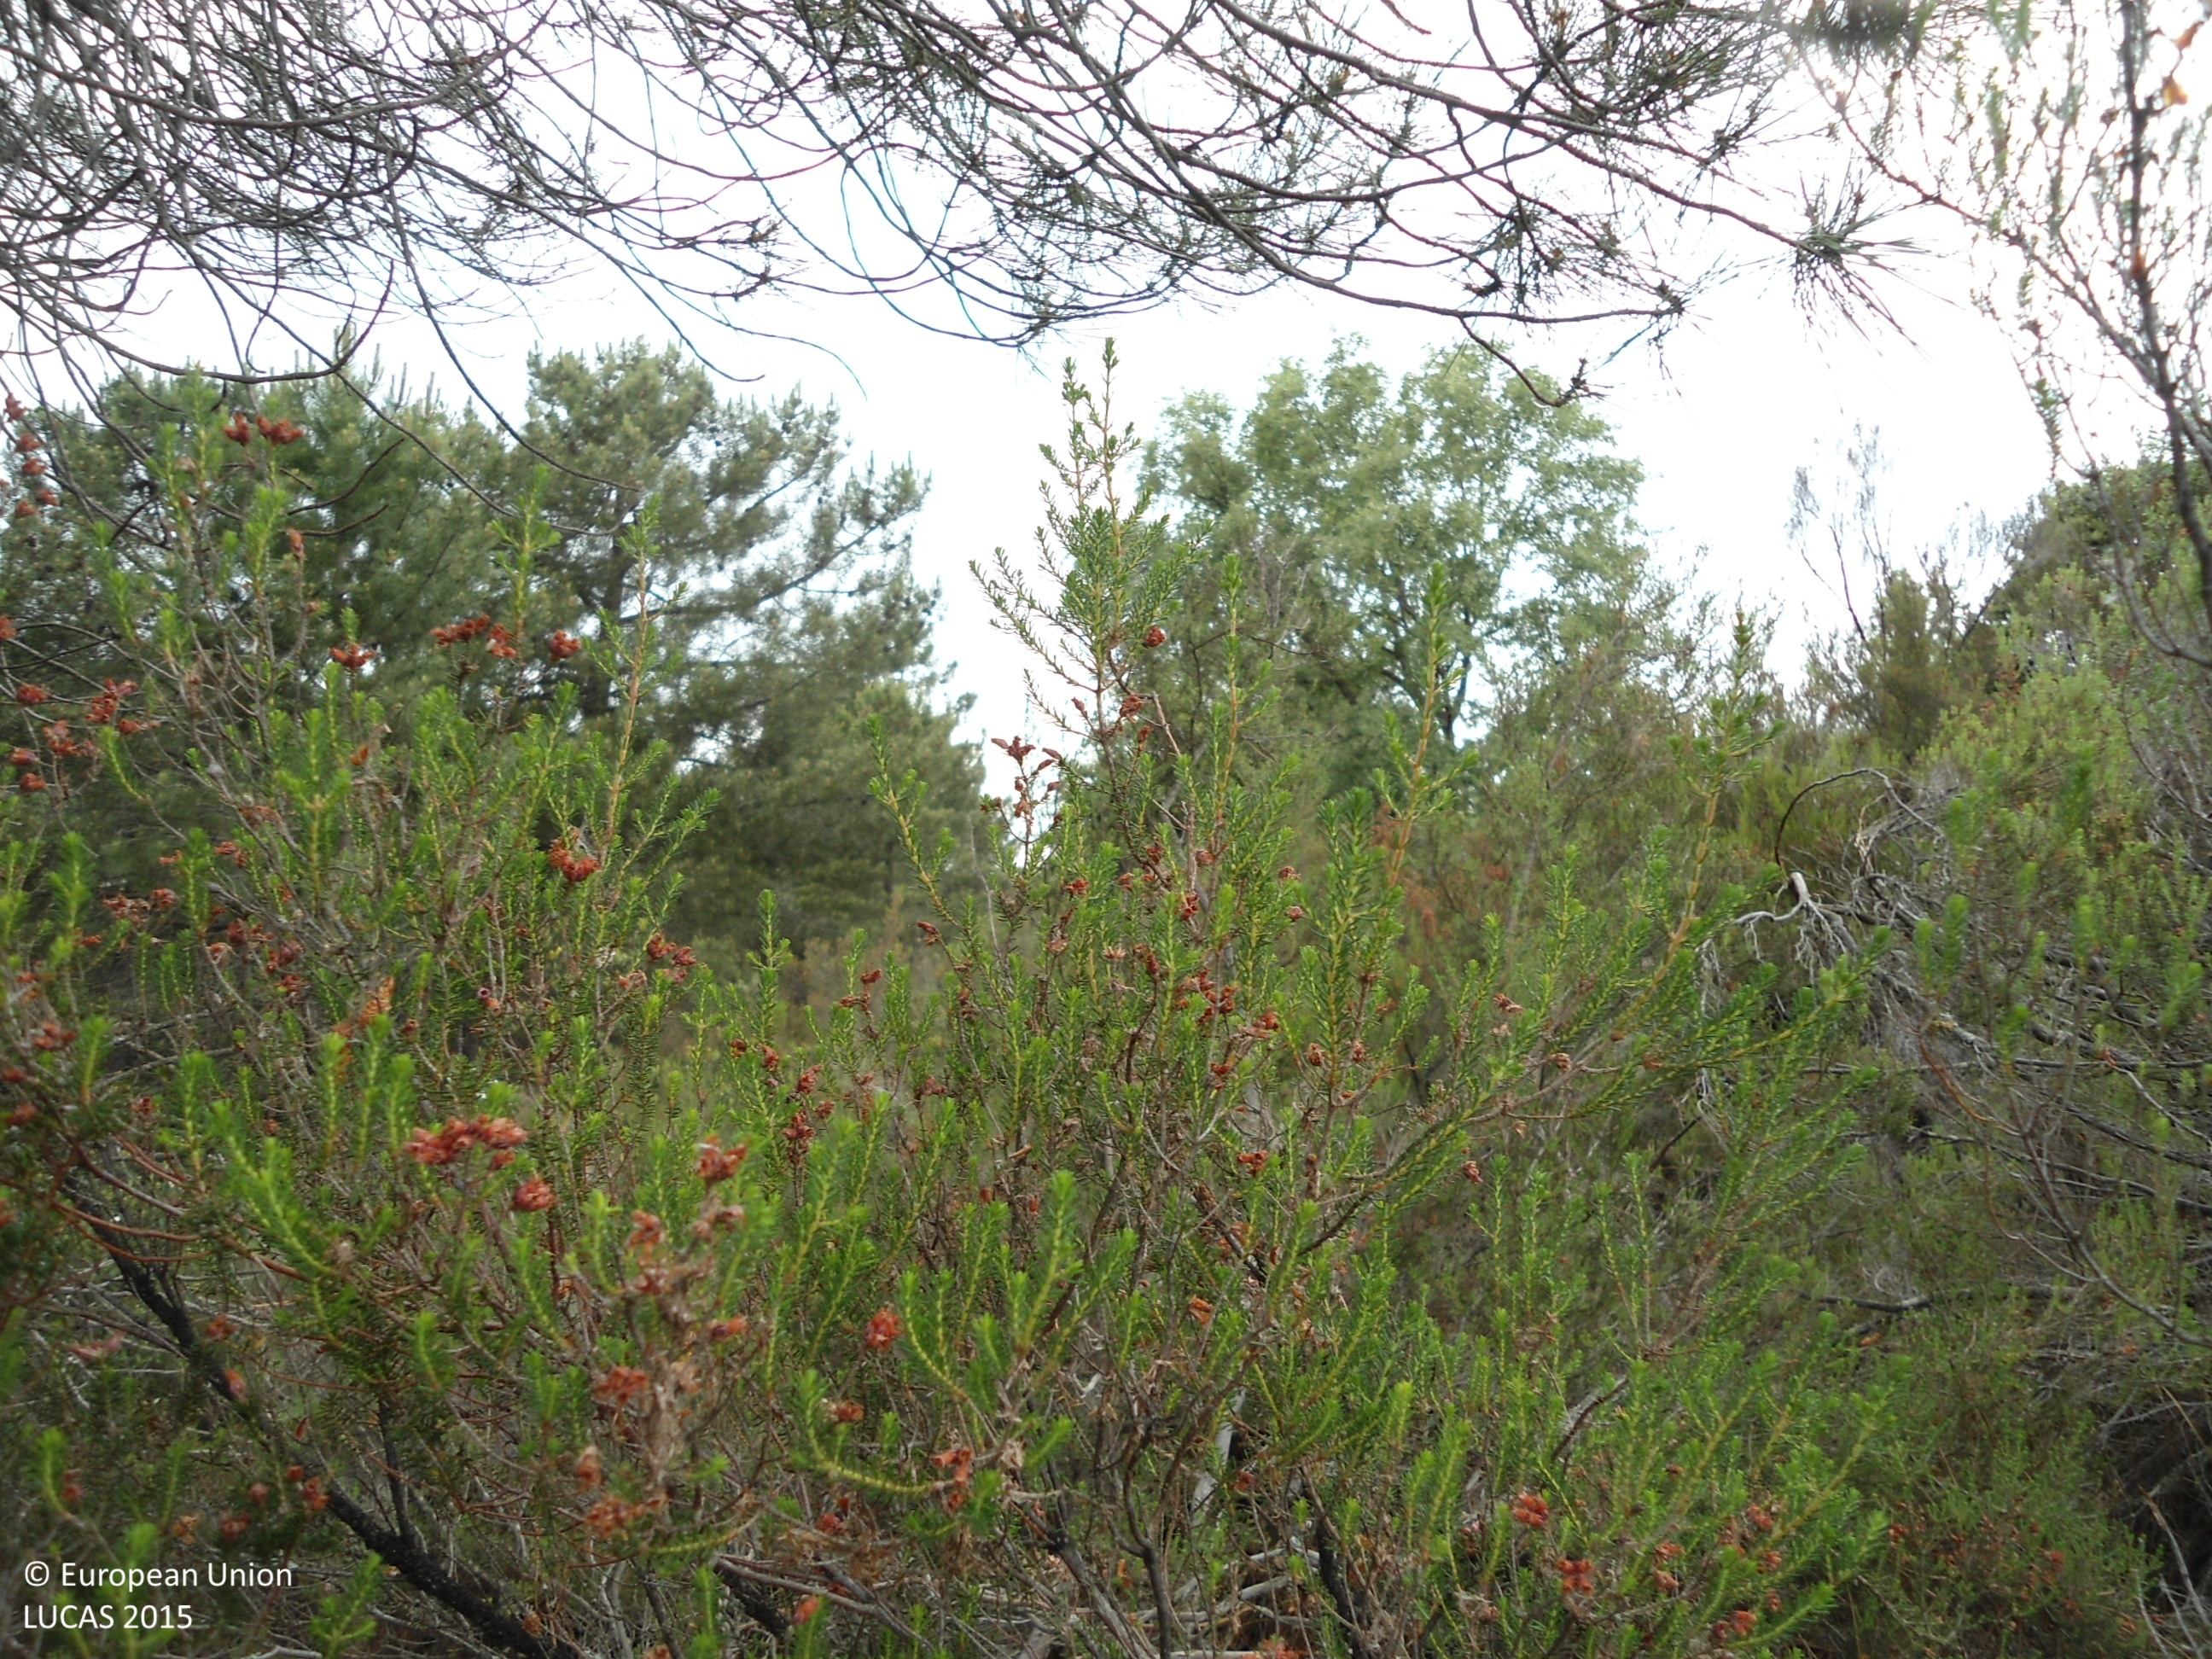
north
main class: Woodland
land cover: Pine dominated mixed woodland
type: coniferous forest of the mediterranean region
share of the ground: > 75 %
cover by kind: coniferous forest trees 65 %, broadleaved forest trees 25 %, shrubs 10 %
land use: Forestry
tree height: > 5 m
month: June
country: ES
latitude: 41.8751
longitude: -6.1867
